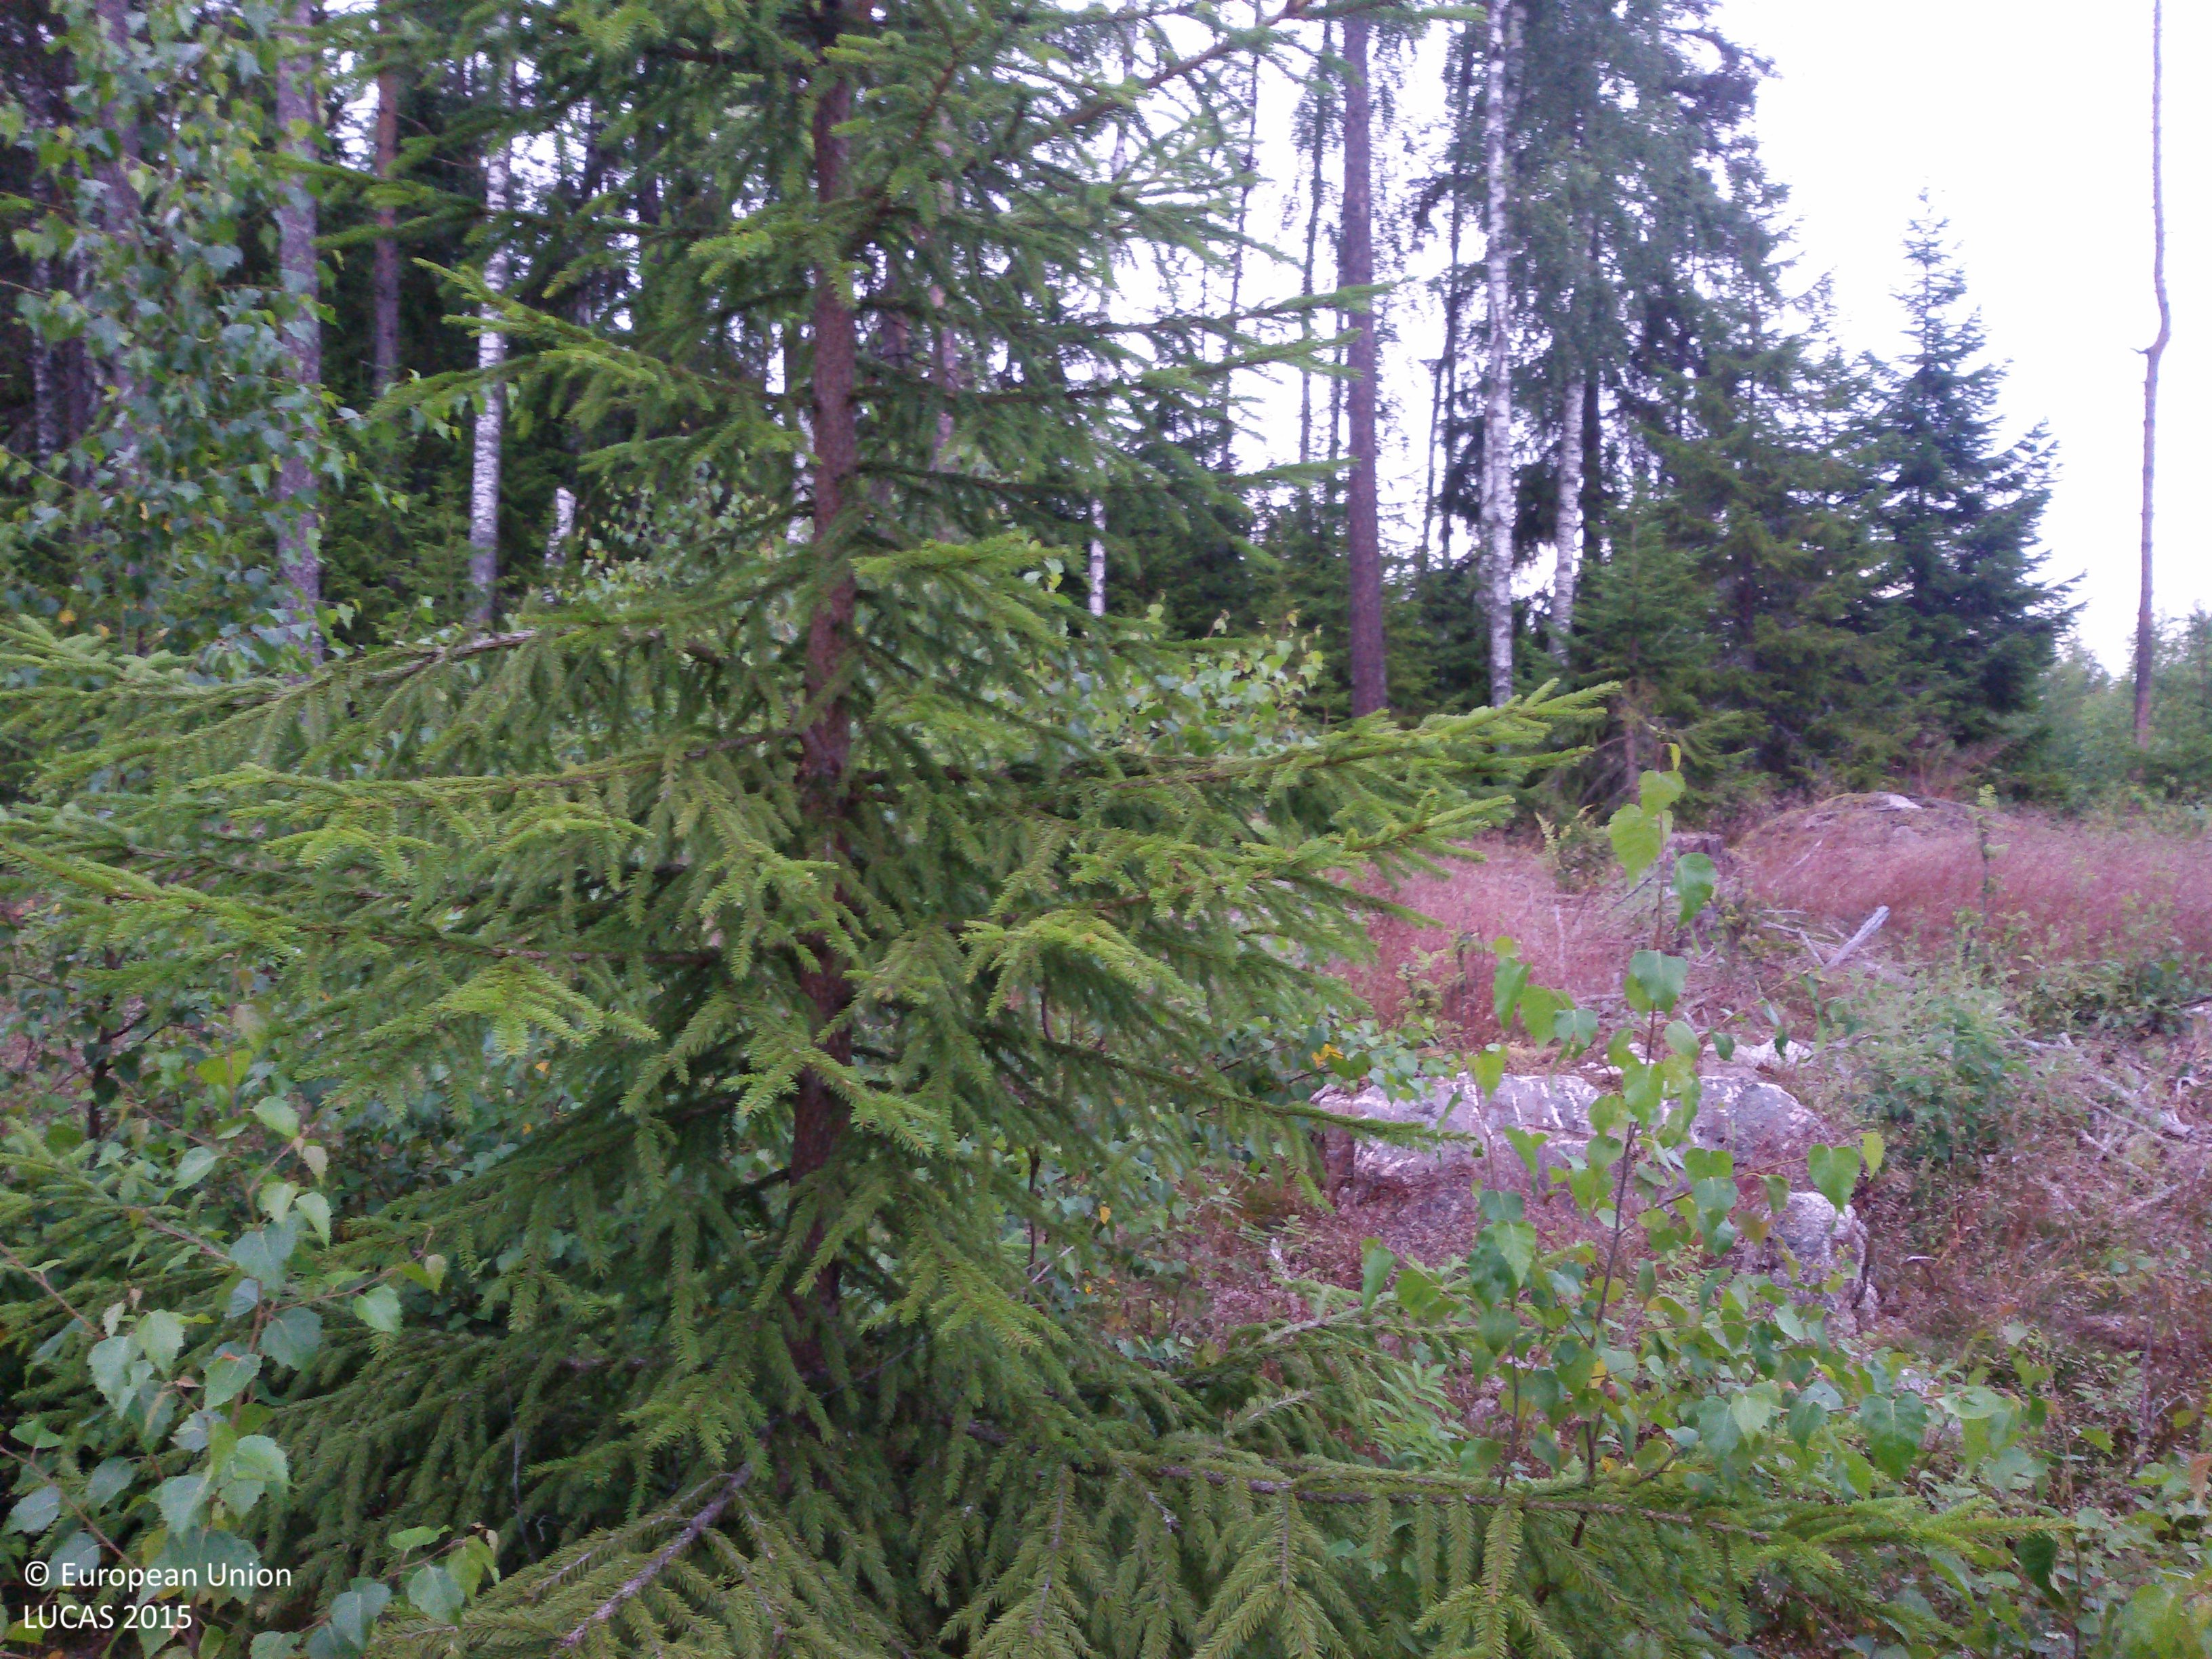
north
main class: Woodland
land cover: Spruce dominated mixed woodland
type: boreal forest
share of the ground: 50 - 75 %
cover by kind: coniferous forest trees 30 %, broadleaved forest trees 30 %, herbaceous plants 20 %, lichens and mosses 20 %
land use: Forestry
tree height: < 5 m
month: July
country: SE
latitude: 60.4383
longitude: 15.8573
